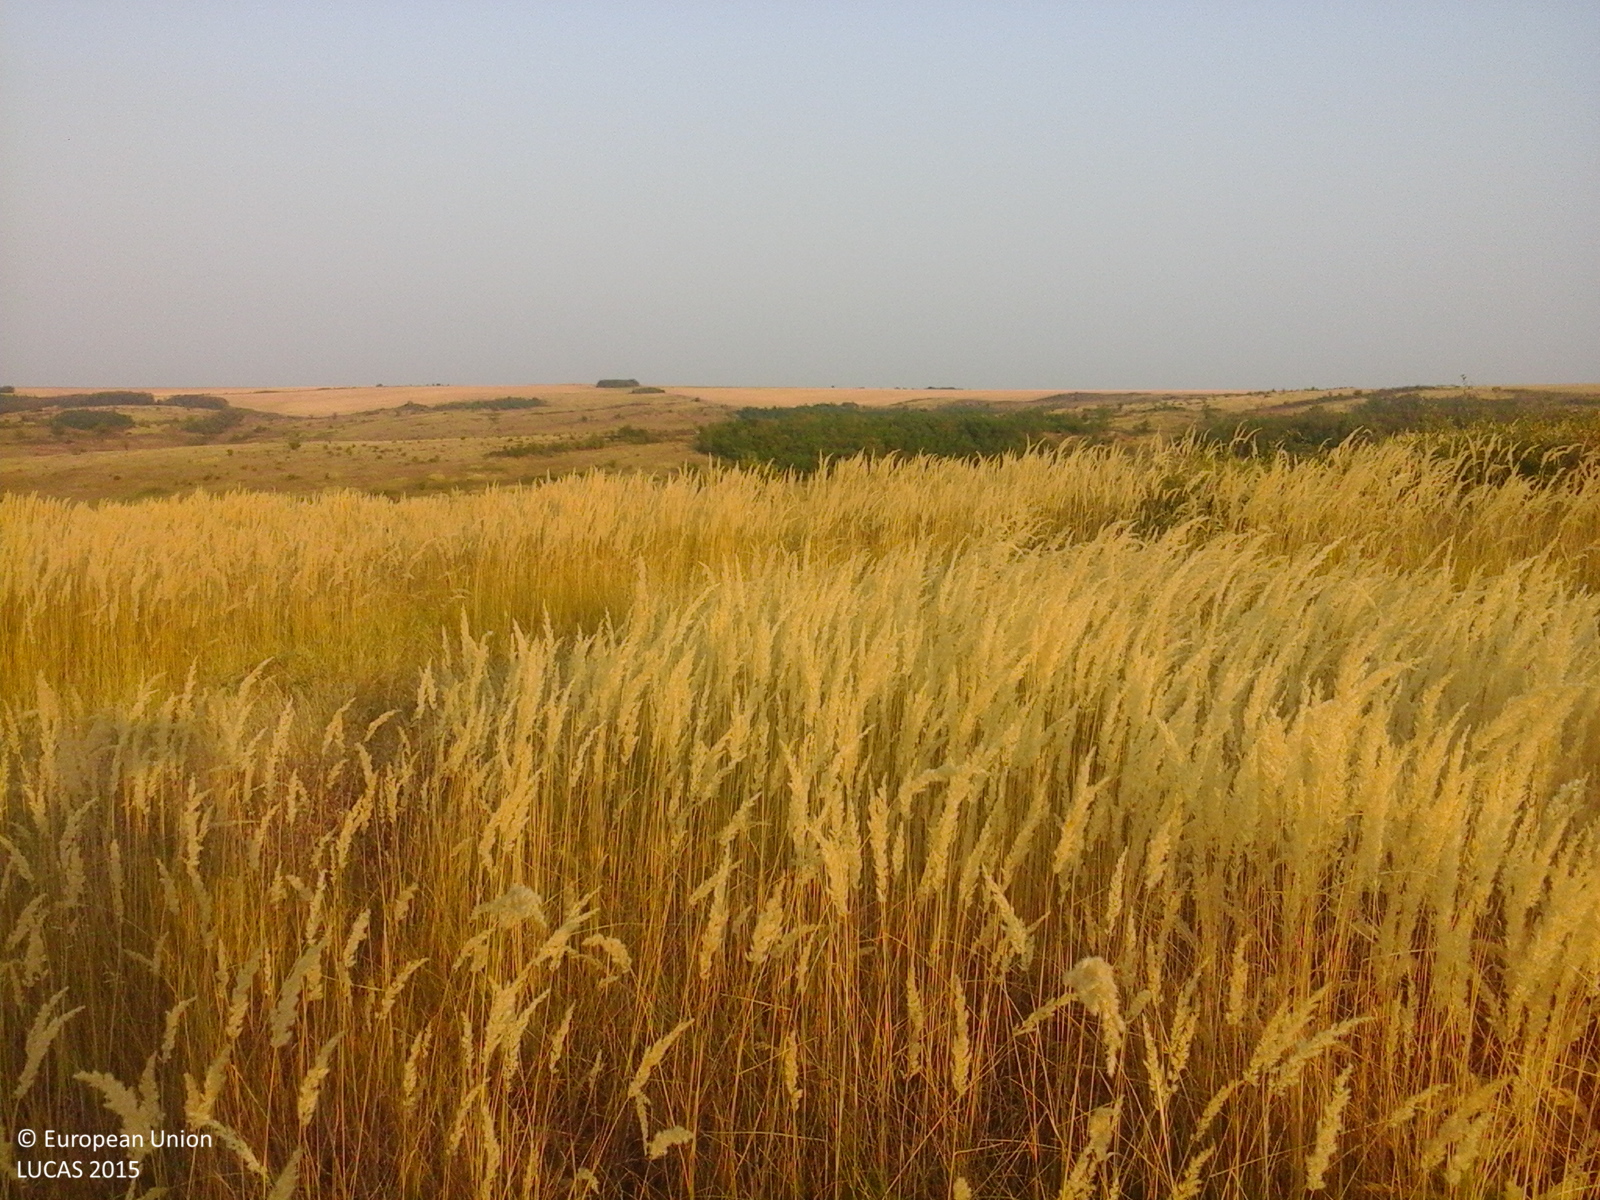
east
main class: Grassland
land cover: Grassland without tree/shrub cover
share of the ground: > 75 %
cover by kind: herbaceous plants 100 %
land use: Agriculture (excluding fallow land and kitchen gardens)
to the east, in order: Grassland without tree/shrub cover; Grassland with sparse tree/shrub cover; Grassland without tree/shrub cover; Grassland with sparse tree/shrub cover; Single bushes/trees; Grassland with sparse tree/shrub cover; Shrubland with sparse tree cover
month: August
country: RO
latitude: 44.3261
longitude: 23.6091
